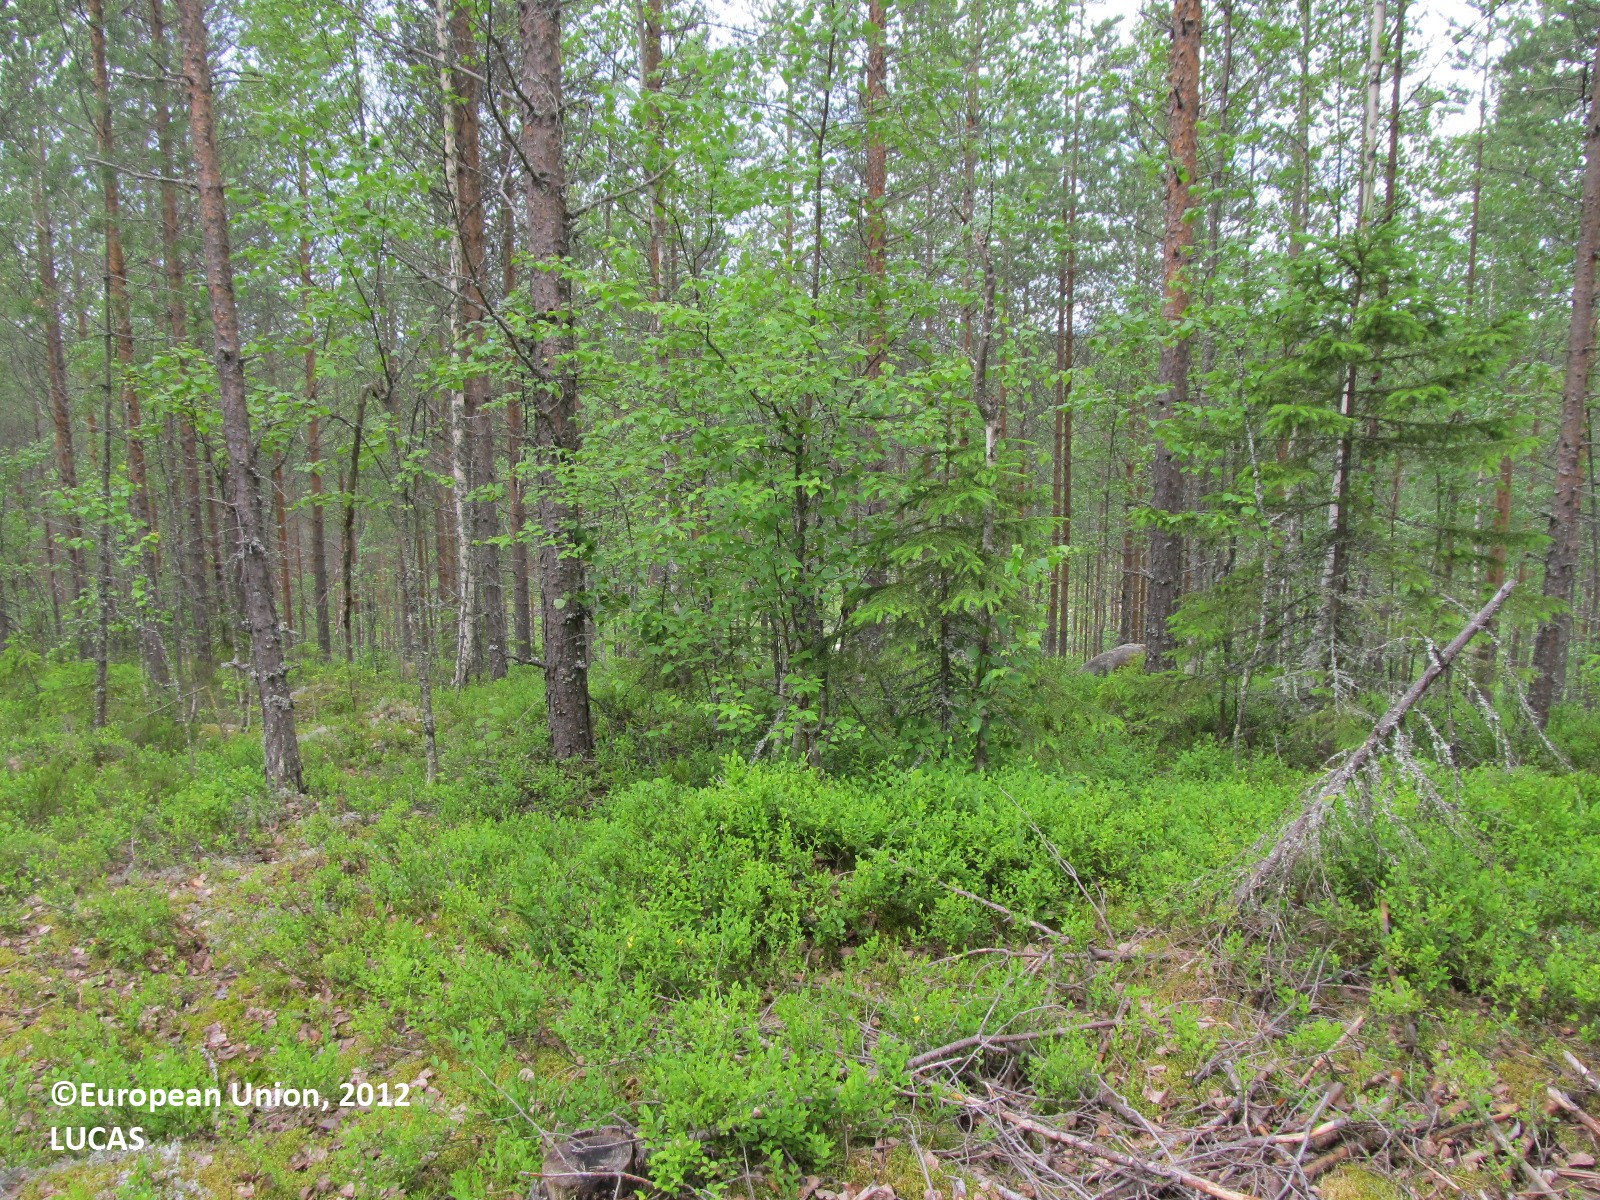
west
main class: Woodland
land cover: Pine dominated coniferous woodland
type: boreal forest
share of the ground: 50 - 75 %
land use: Forestry
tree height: > 5 m
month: June
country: FI
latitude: 62.8403
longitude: 28.8450
